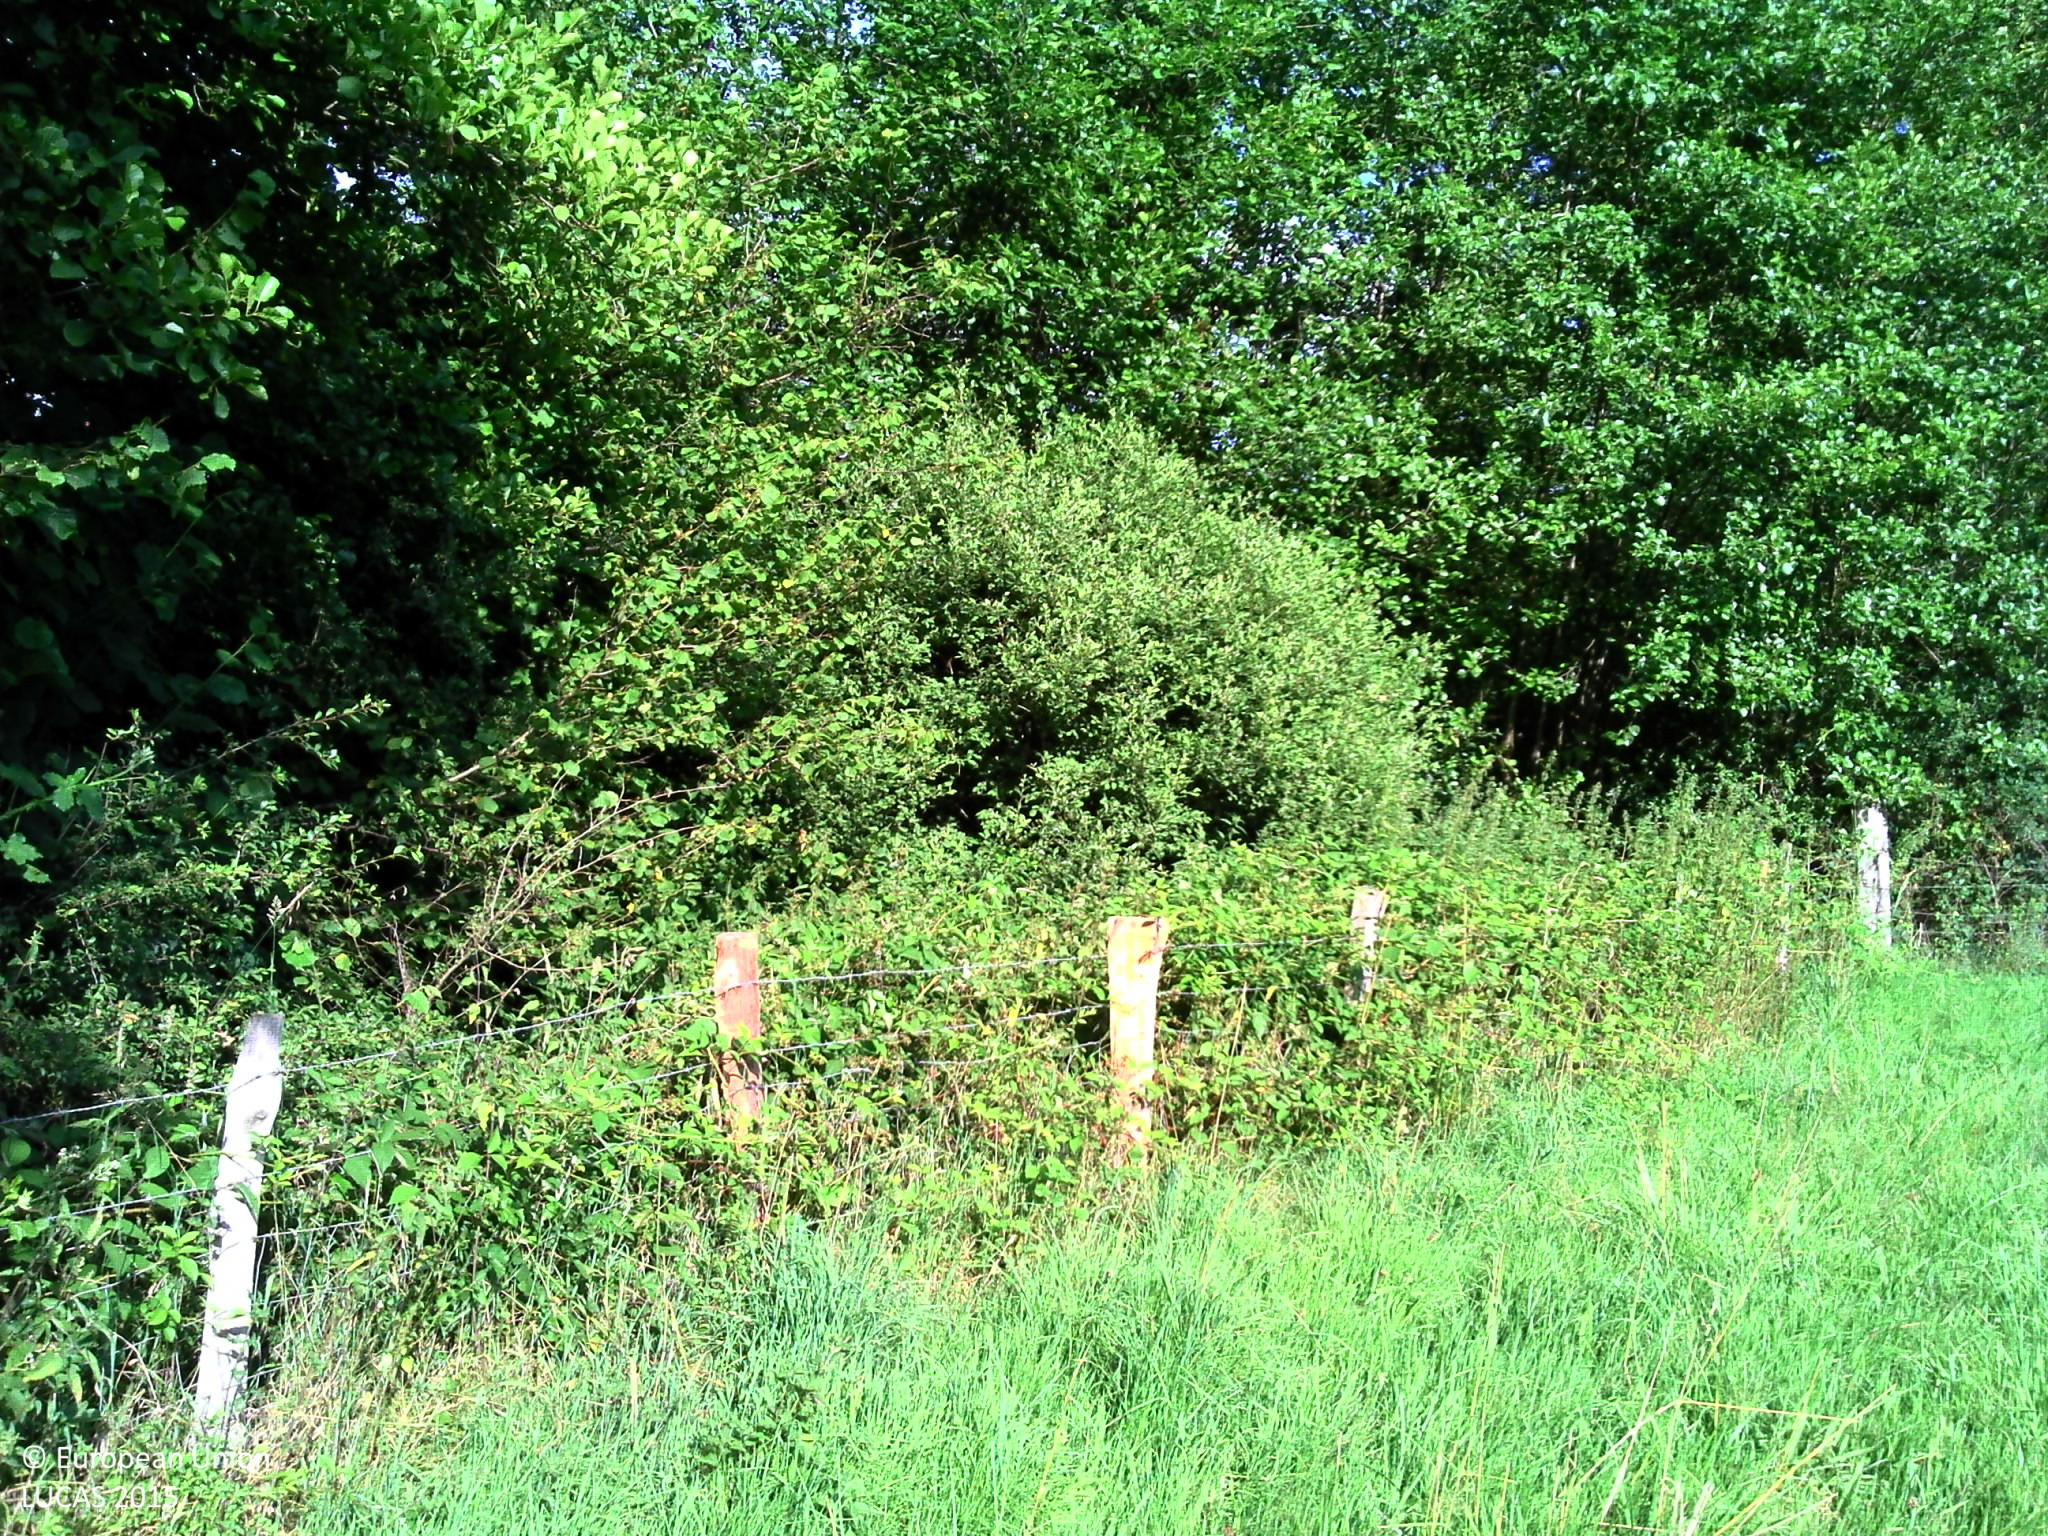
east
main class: Grassland
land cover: Grassland without tree/shrub cover
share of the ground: > 75 %
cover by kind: herbaceous plants 95 %
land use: Agriculture (excluding fallow land and kitchen gardens)
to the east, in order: Grassland without tree/shrub cover; Fences; Groves; Rivers and streams; Broadleaved woodland; Grassland without tree/shrub cover; Fences; Broadleaved woodland; Fences; Grassland without tree/shrub cover
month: July
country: FR
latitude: 45.6912
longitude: 1.7889
